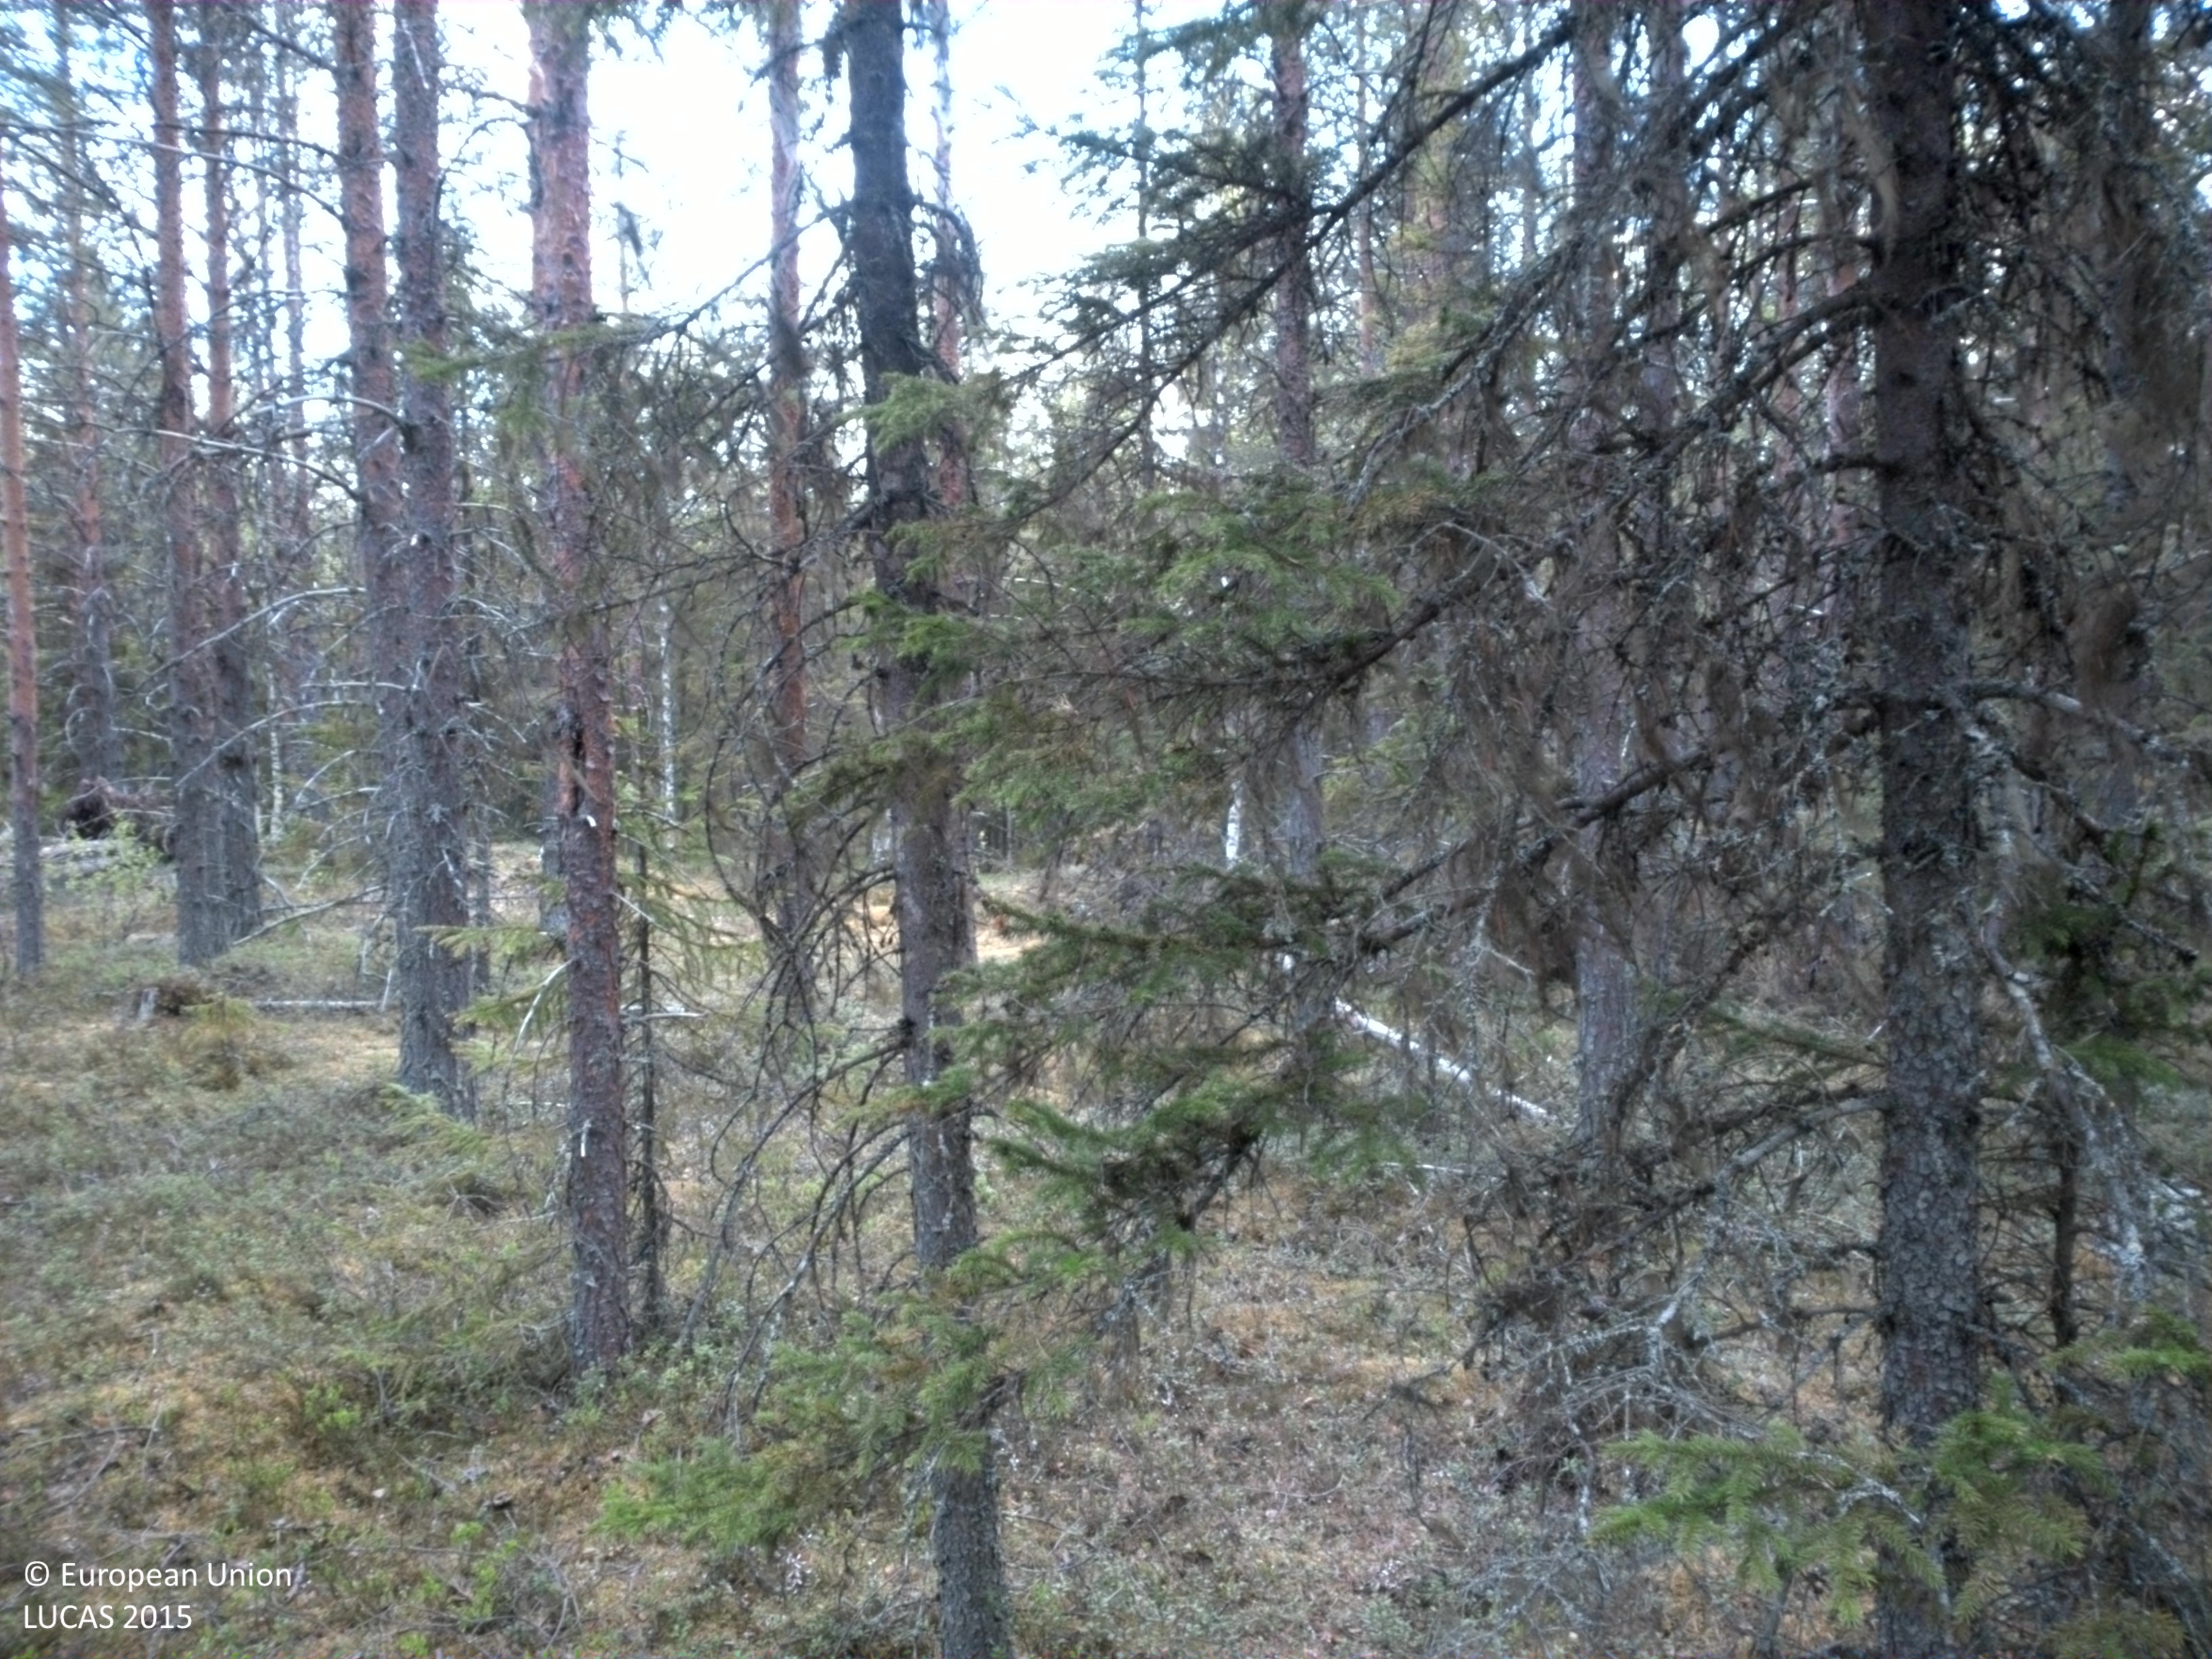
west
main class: Woodland
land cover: Pine dominated coniferous woodland
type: boreal forest
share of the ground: 50 - 75 %
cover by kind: coniferous forest trees 50 %, lichens and mosses 20 %, herbaceous plants 15 %, broadleaved forest trees 5 %, shrubs 5 %, unconsolidated bare surface 5 %
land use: Forestry
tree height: > 5 m
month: June
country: SE
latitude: 64.2090
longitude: 17.3645
